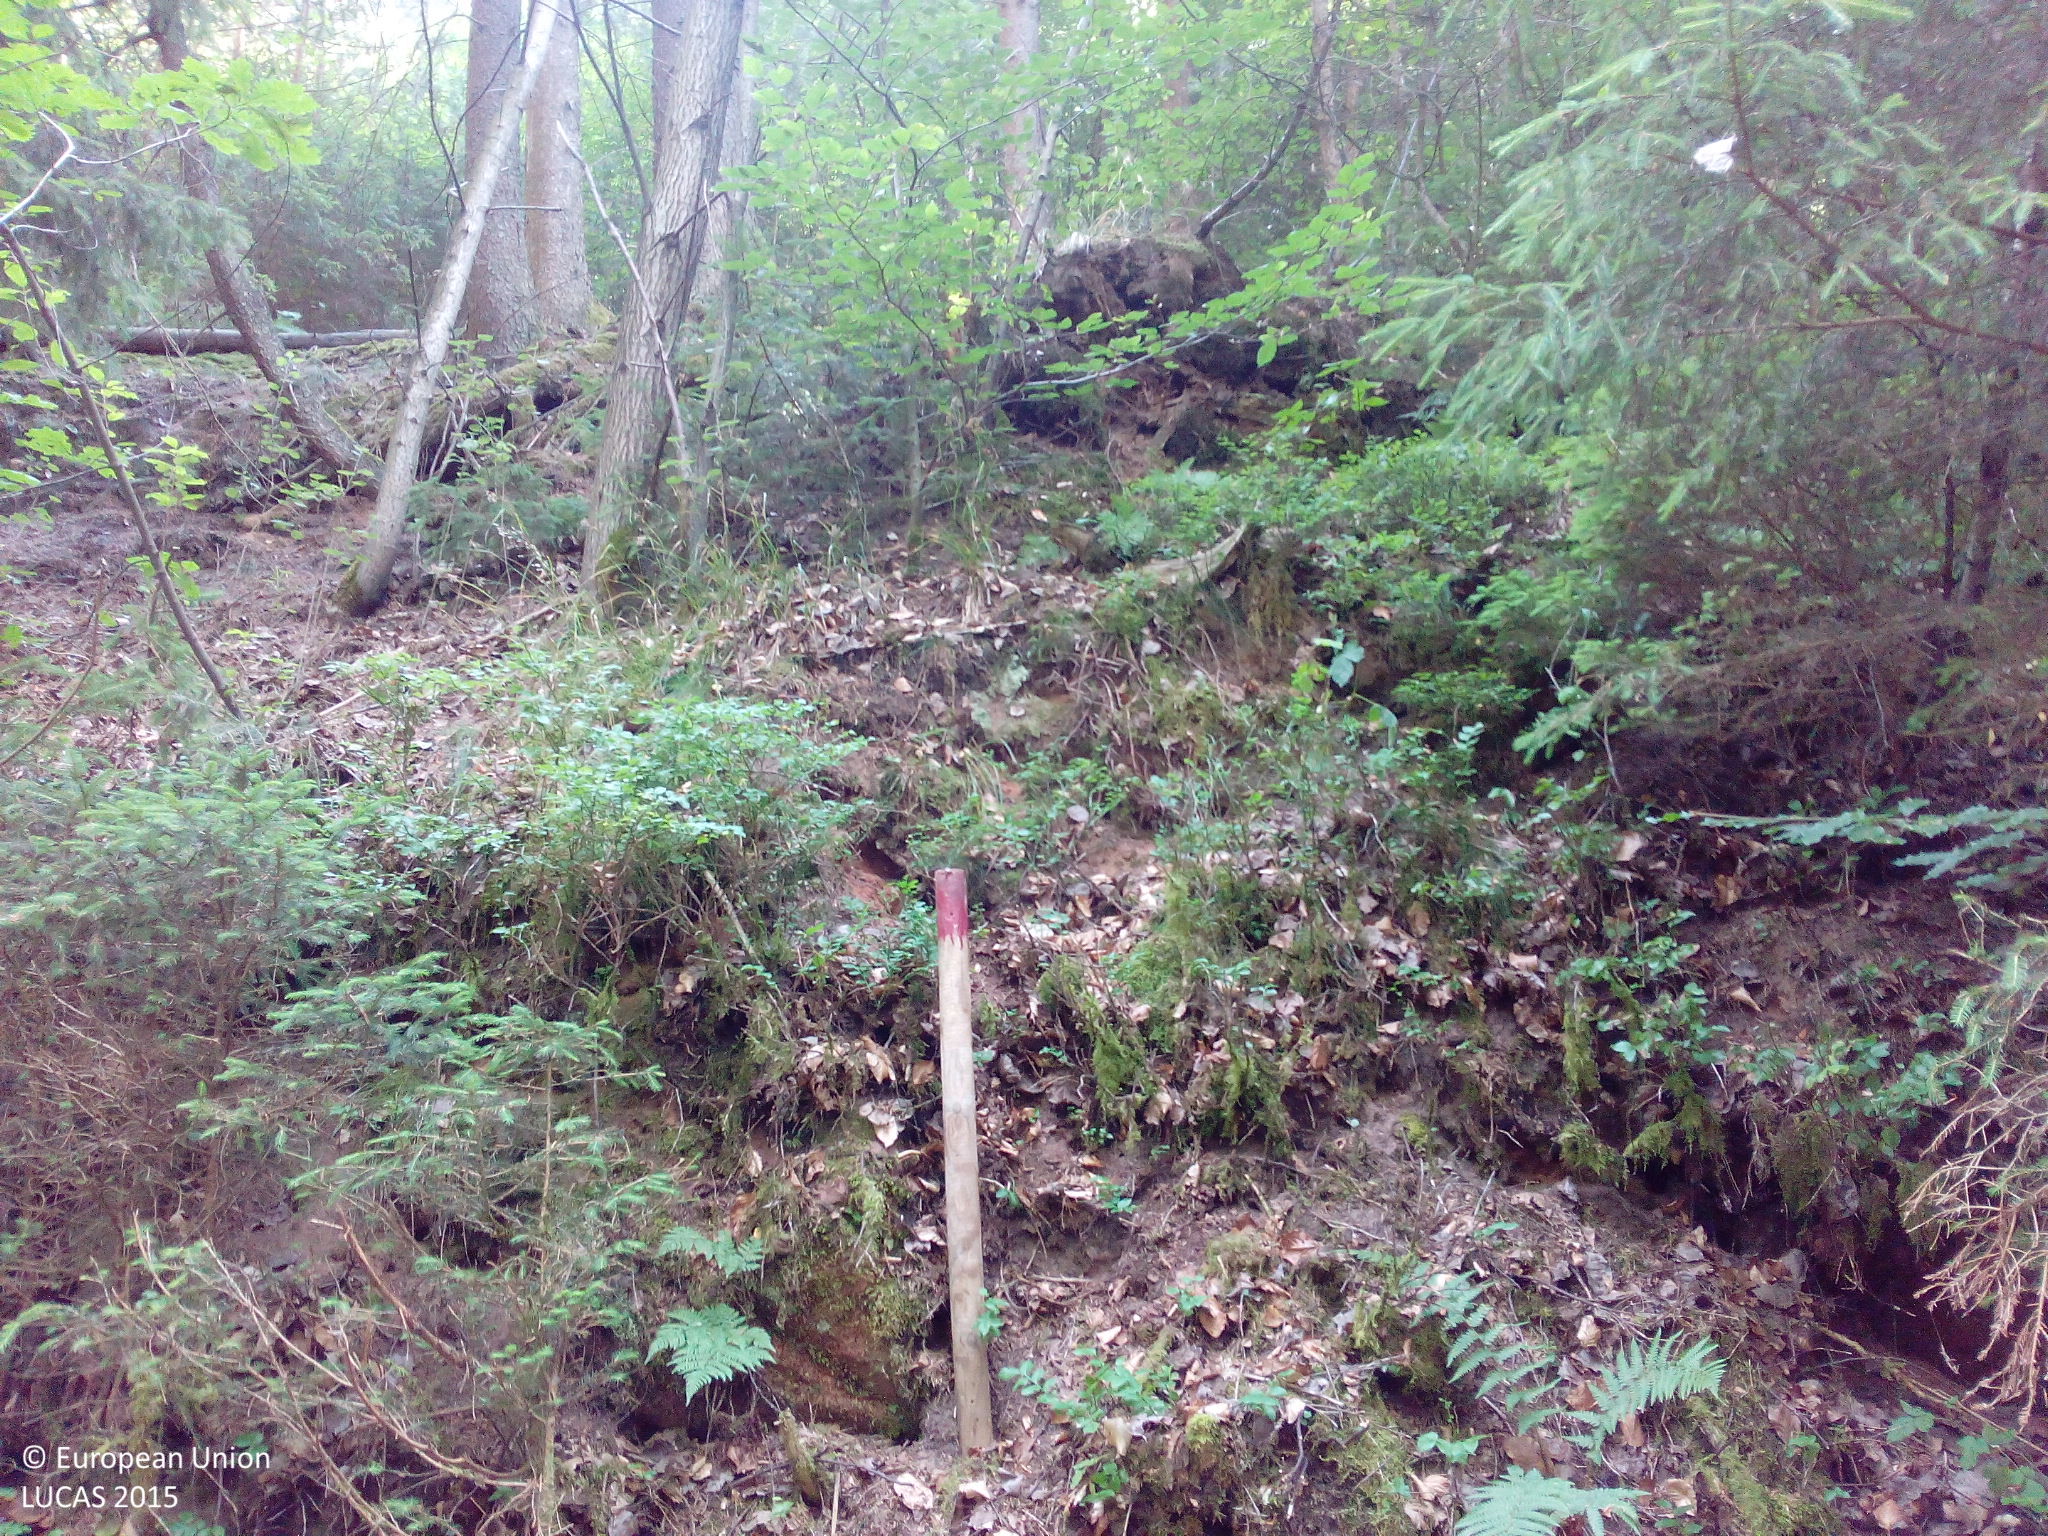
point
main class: Woodland
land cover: Spruce dominated mixed woodland
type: hemiboreal forest and nemoral coniferous forest and mixed broadleaved-coniferous forest
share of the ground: > 75 %
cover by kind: coniferous forest trees 60 %, broadleaved forest trees 20 %, unconsolidated bare surface 10 %, shrubs 5 %, herbaceous plants 5 %
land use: Forestry
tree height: > 5 m
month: July
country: DE
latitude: 49.1317
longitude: 7.5199
